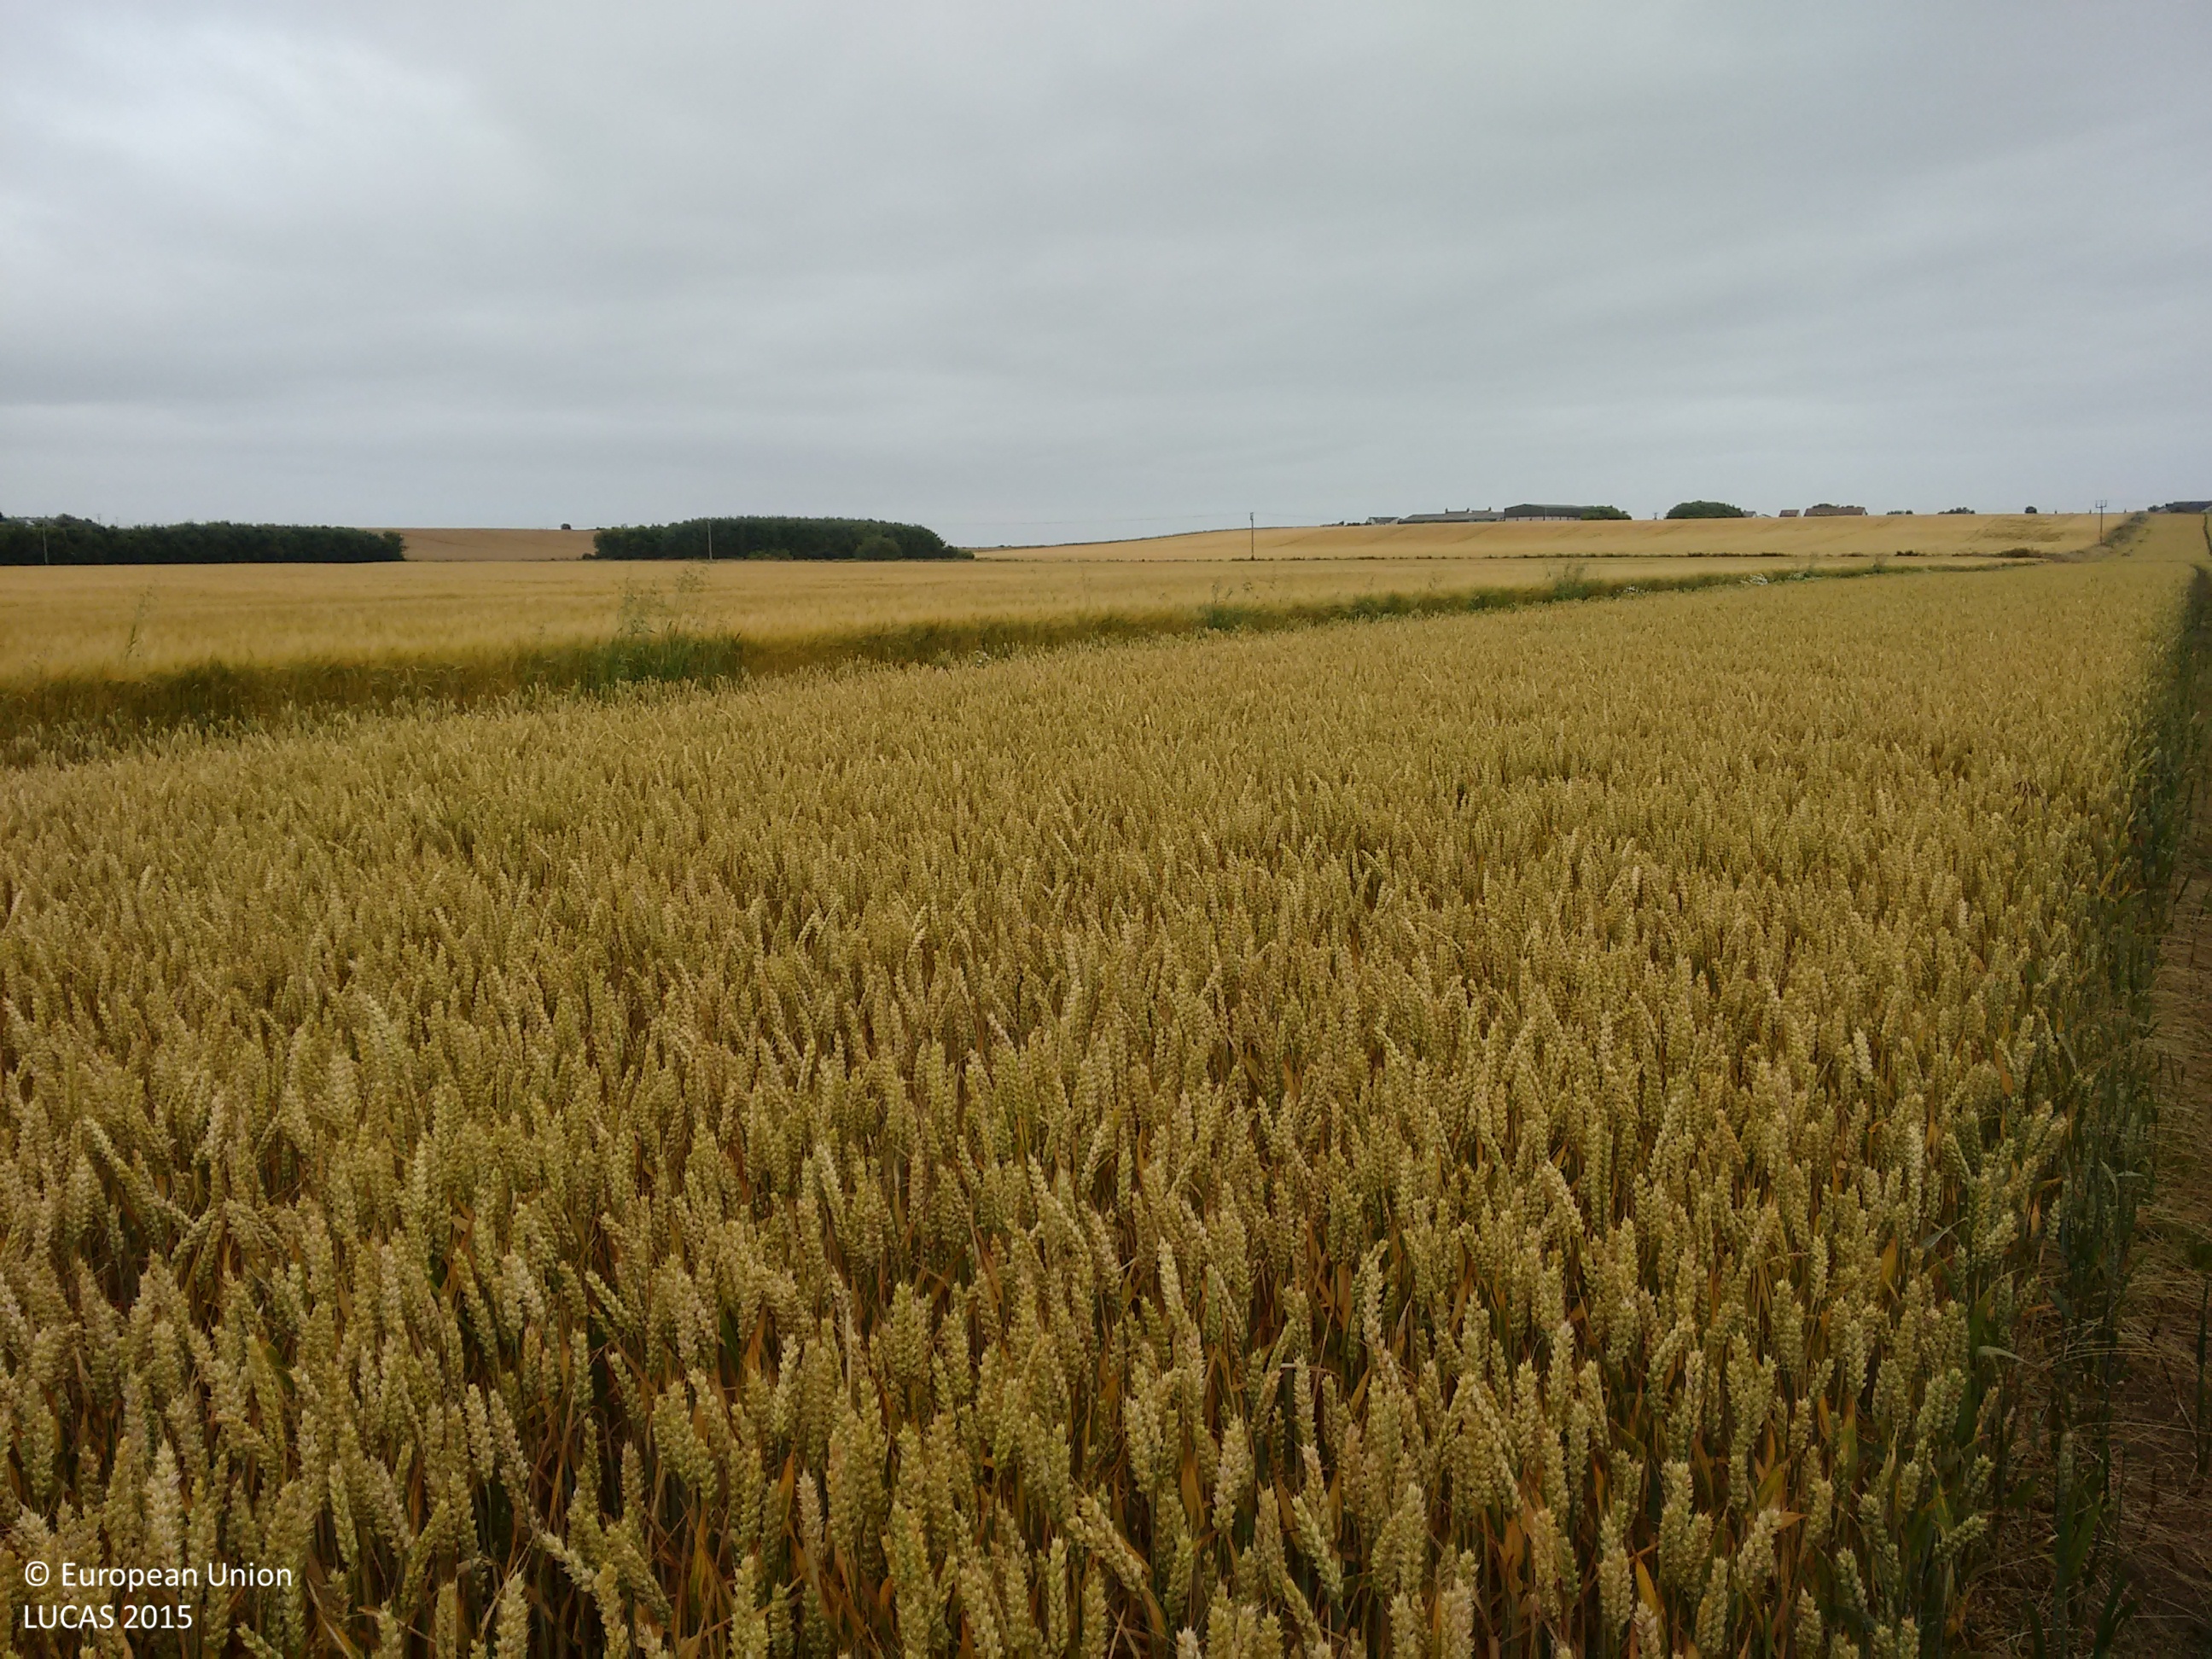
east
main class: Cropland
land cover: Common wheat
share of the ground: > 75 %
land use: Agriculture (excluding fallow land and kitchen gardens)
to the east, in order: Common wheat; Barley
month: August
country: GB
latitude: 57.7655
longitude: -3.9112
